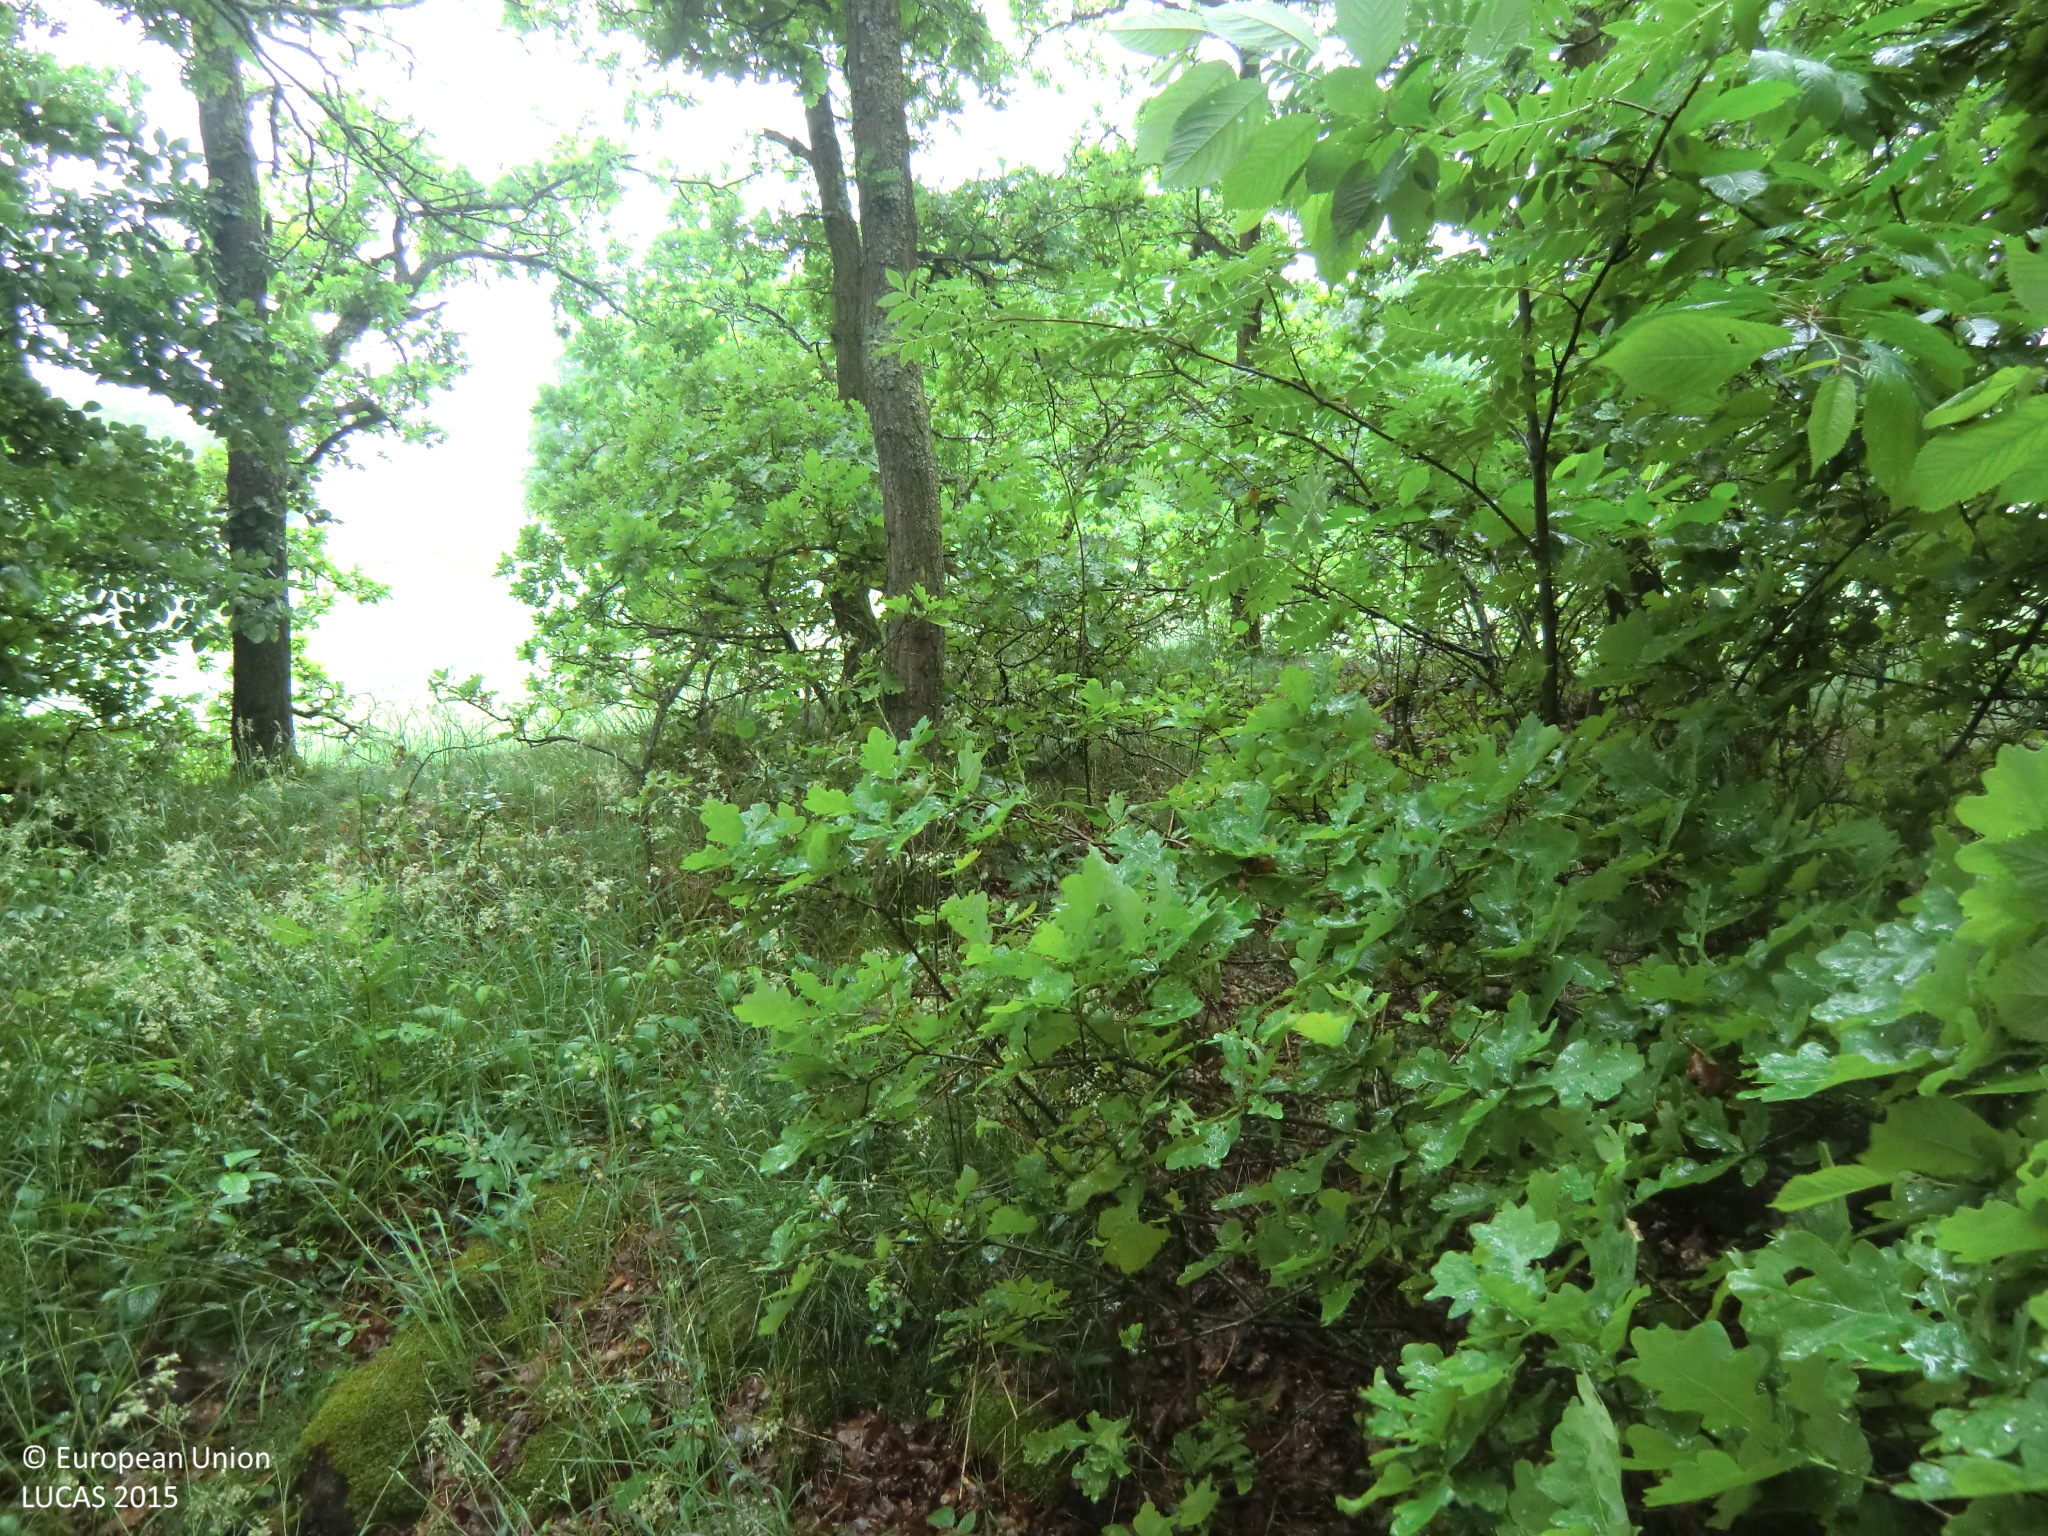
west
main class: Woodland
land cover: Broadleaved woodland
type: acidophilous oak and oak-birch forest
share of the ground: > 75 %
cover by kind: broadleaved forest trees 80 %, herbaceous plants 20 %
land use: Semi-natural and natural areas not in use
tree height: > 5 m
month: May
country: AT
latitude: 48.4043
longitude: 14.4447
